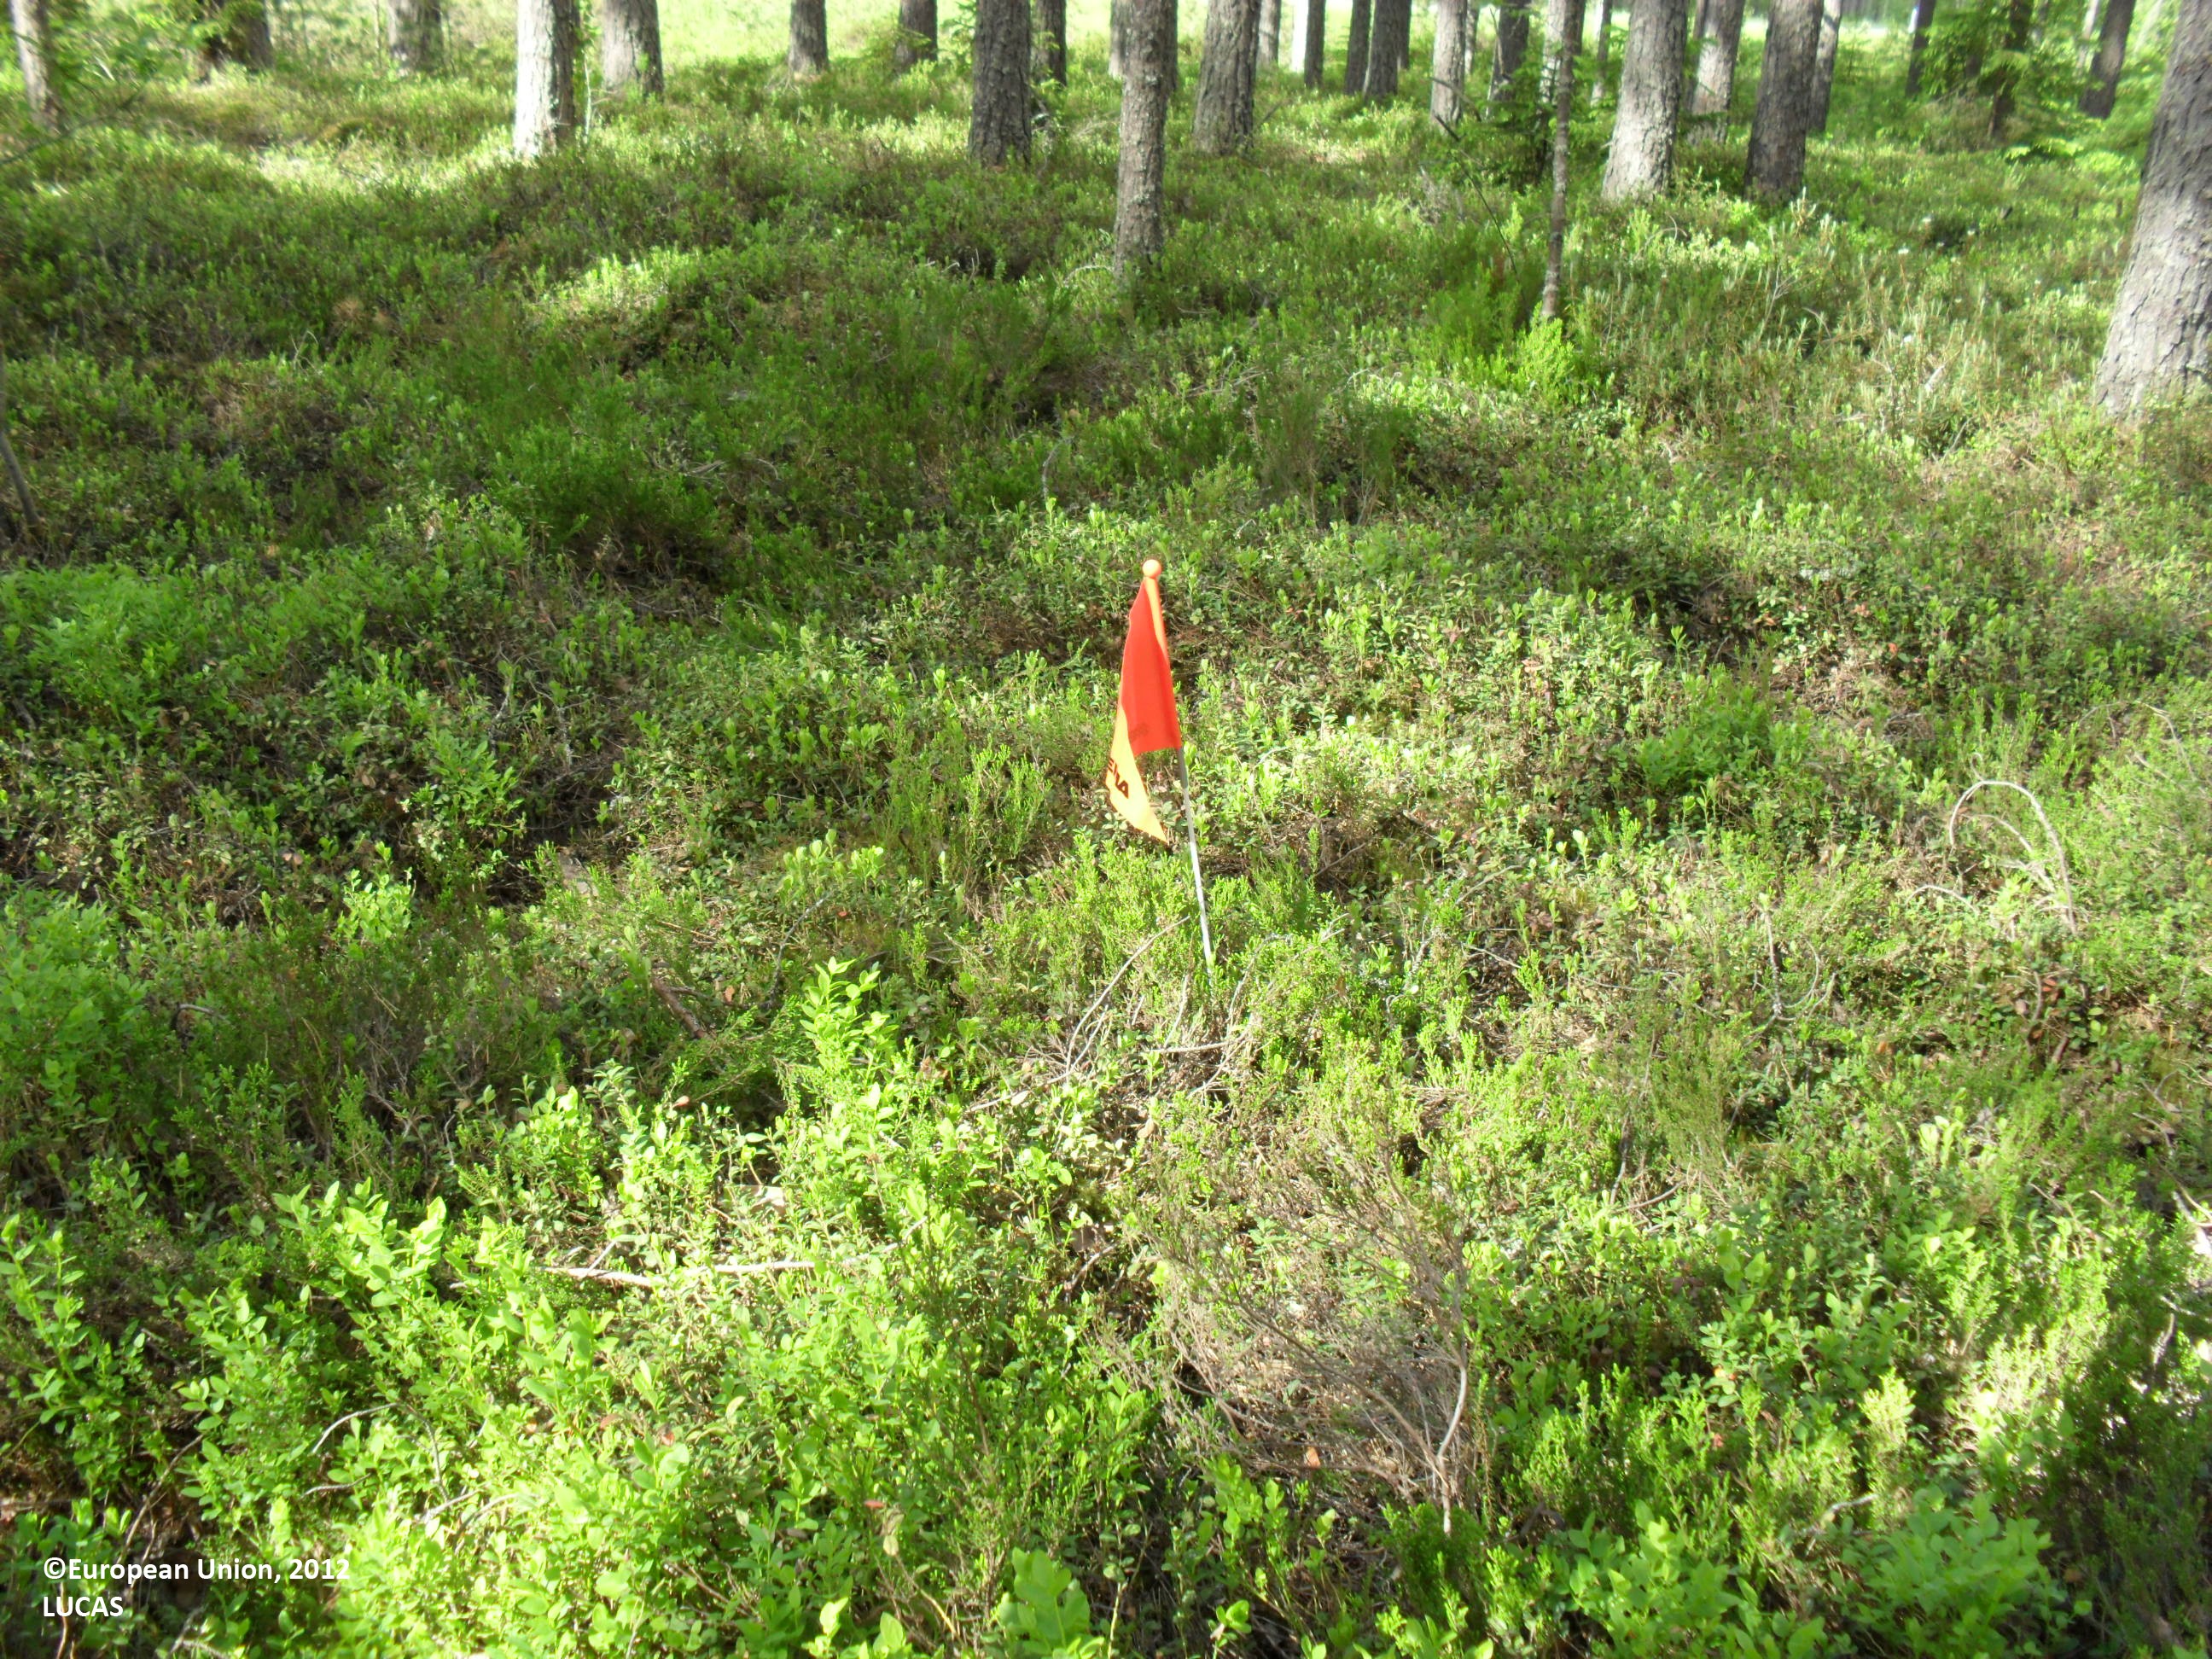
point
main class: Woodland
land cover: Pine dominated coniferous woodland
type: boreal forest
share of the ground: 50 - 75 %
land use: Forestry
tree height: > 5 m
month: June
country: FI
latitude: 62.7650
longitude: 23.3657
